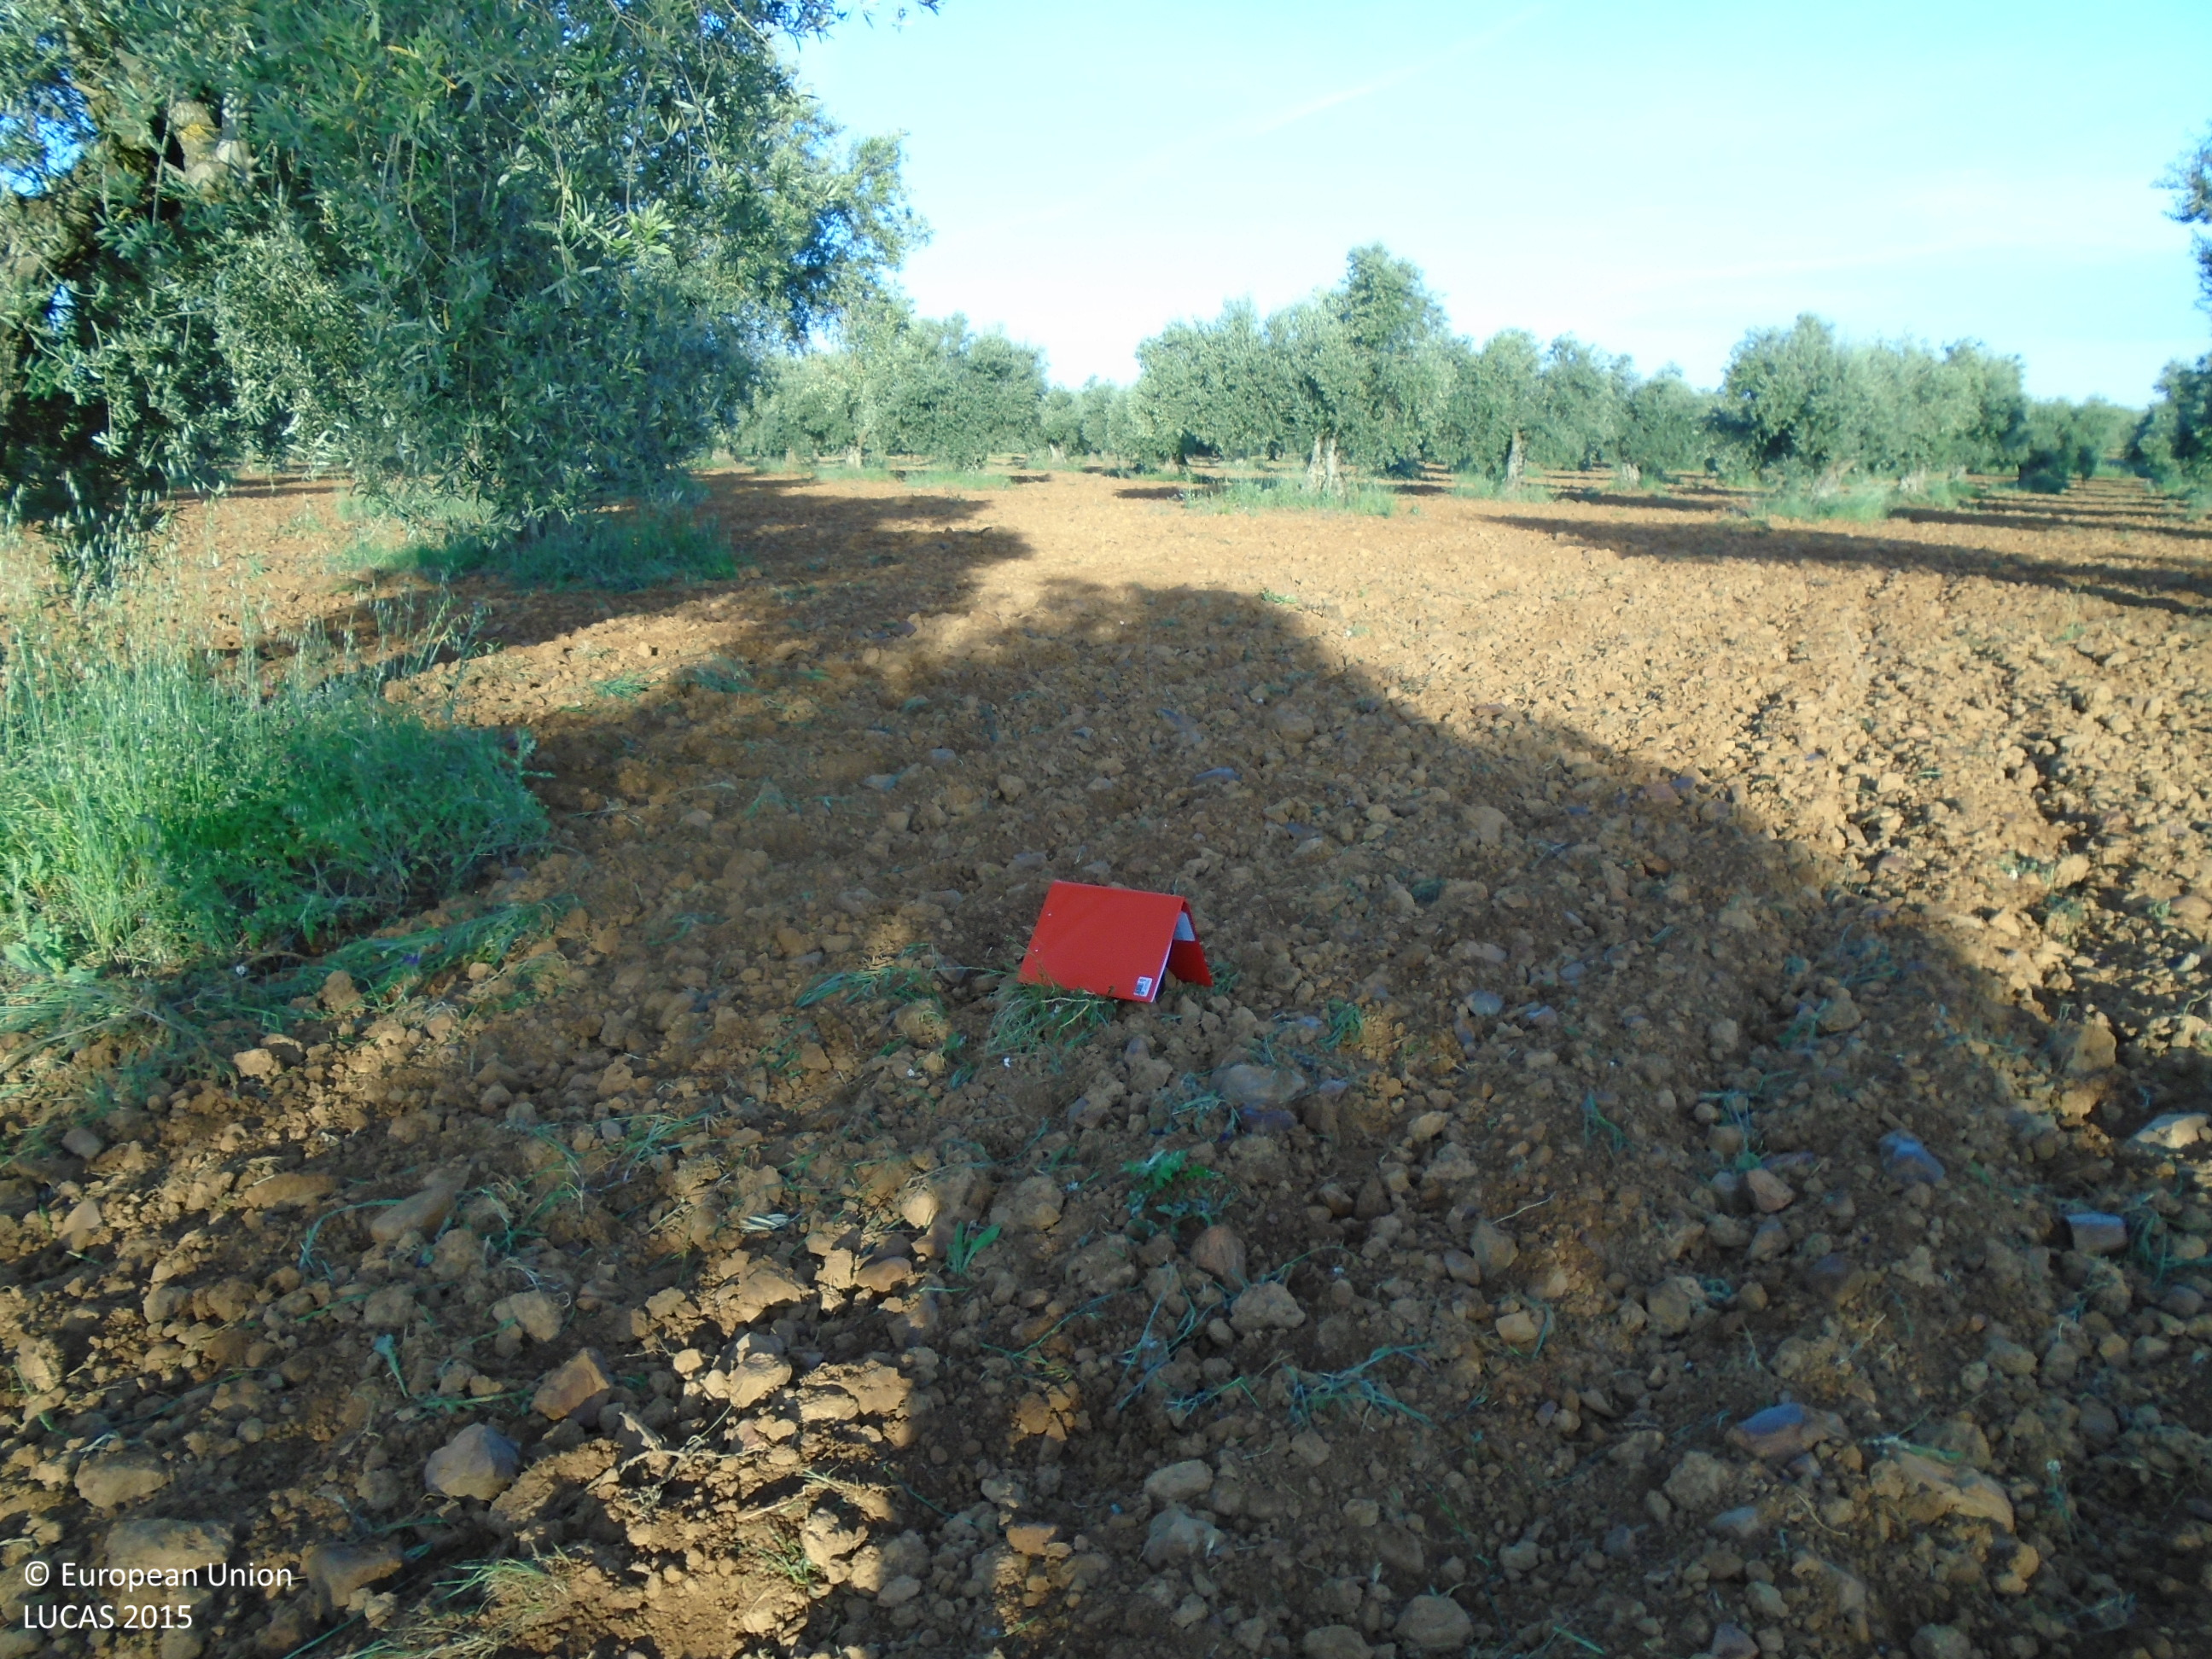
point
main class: Cropland
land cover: Olive groves
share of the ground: 10 - 25 %
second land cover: Other bare soil
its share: > 75 %
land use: Agriculture (excluding fallow land and kitchen gardens)
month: May
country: ES
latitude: 39.8100
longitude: -4.7269
